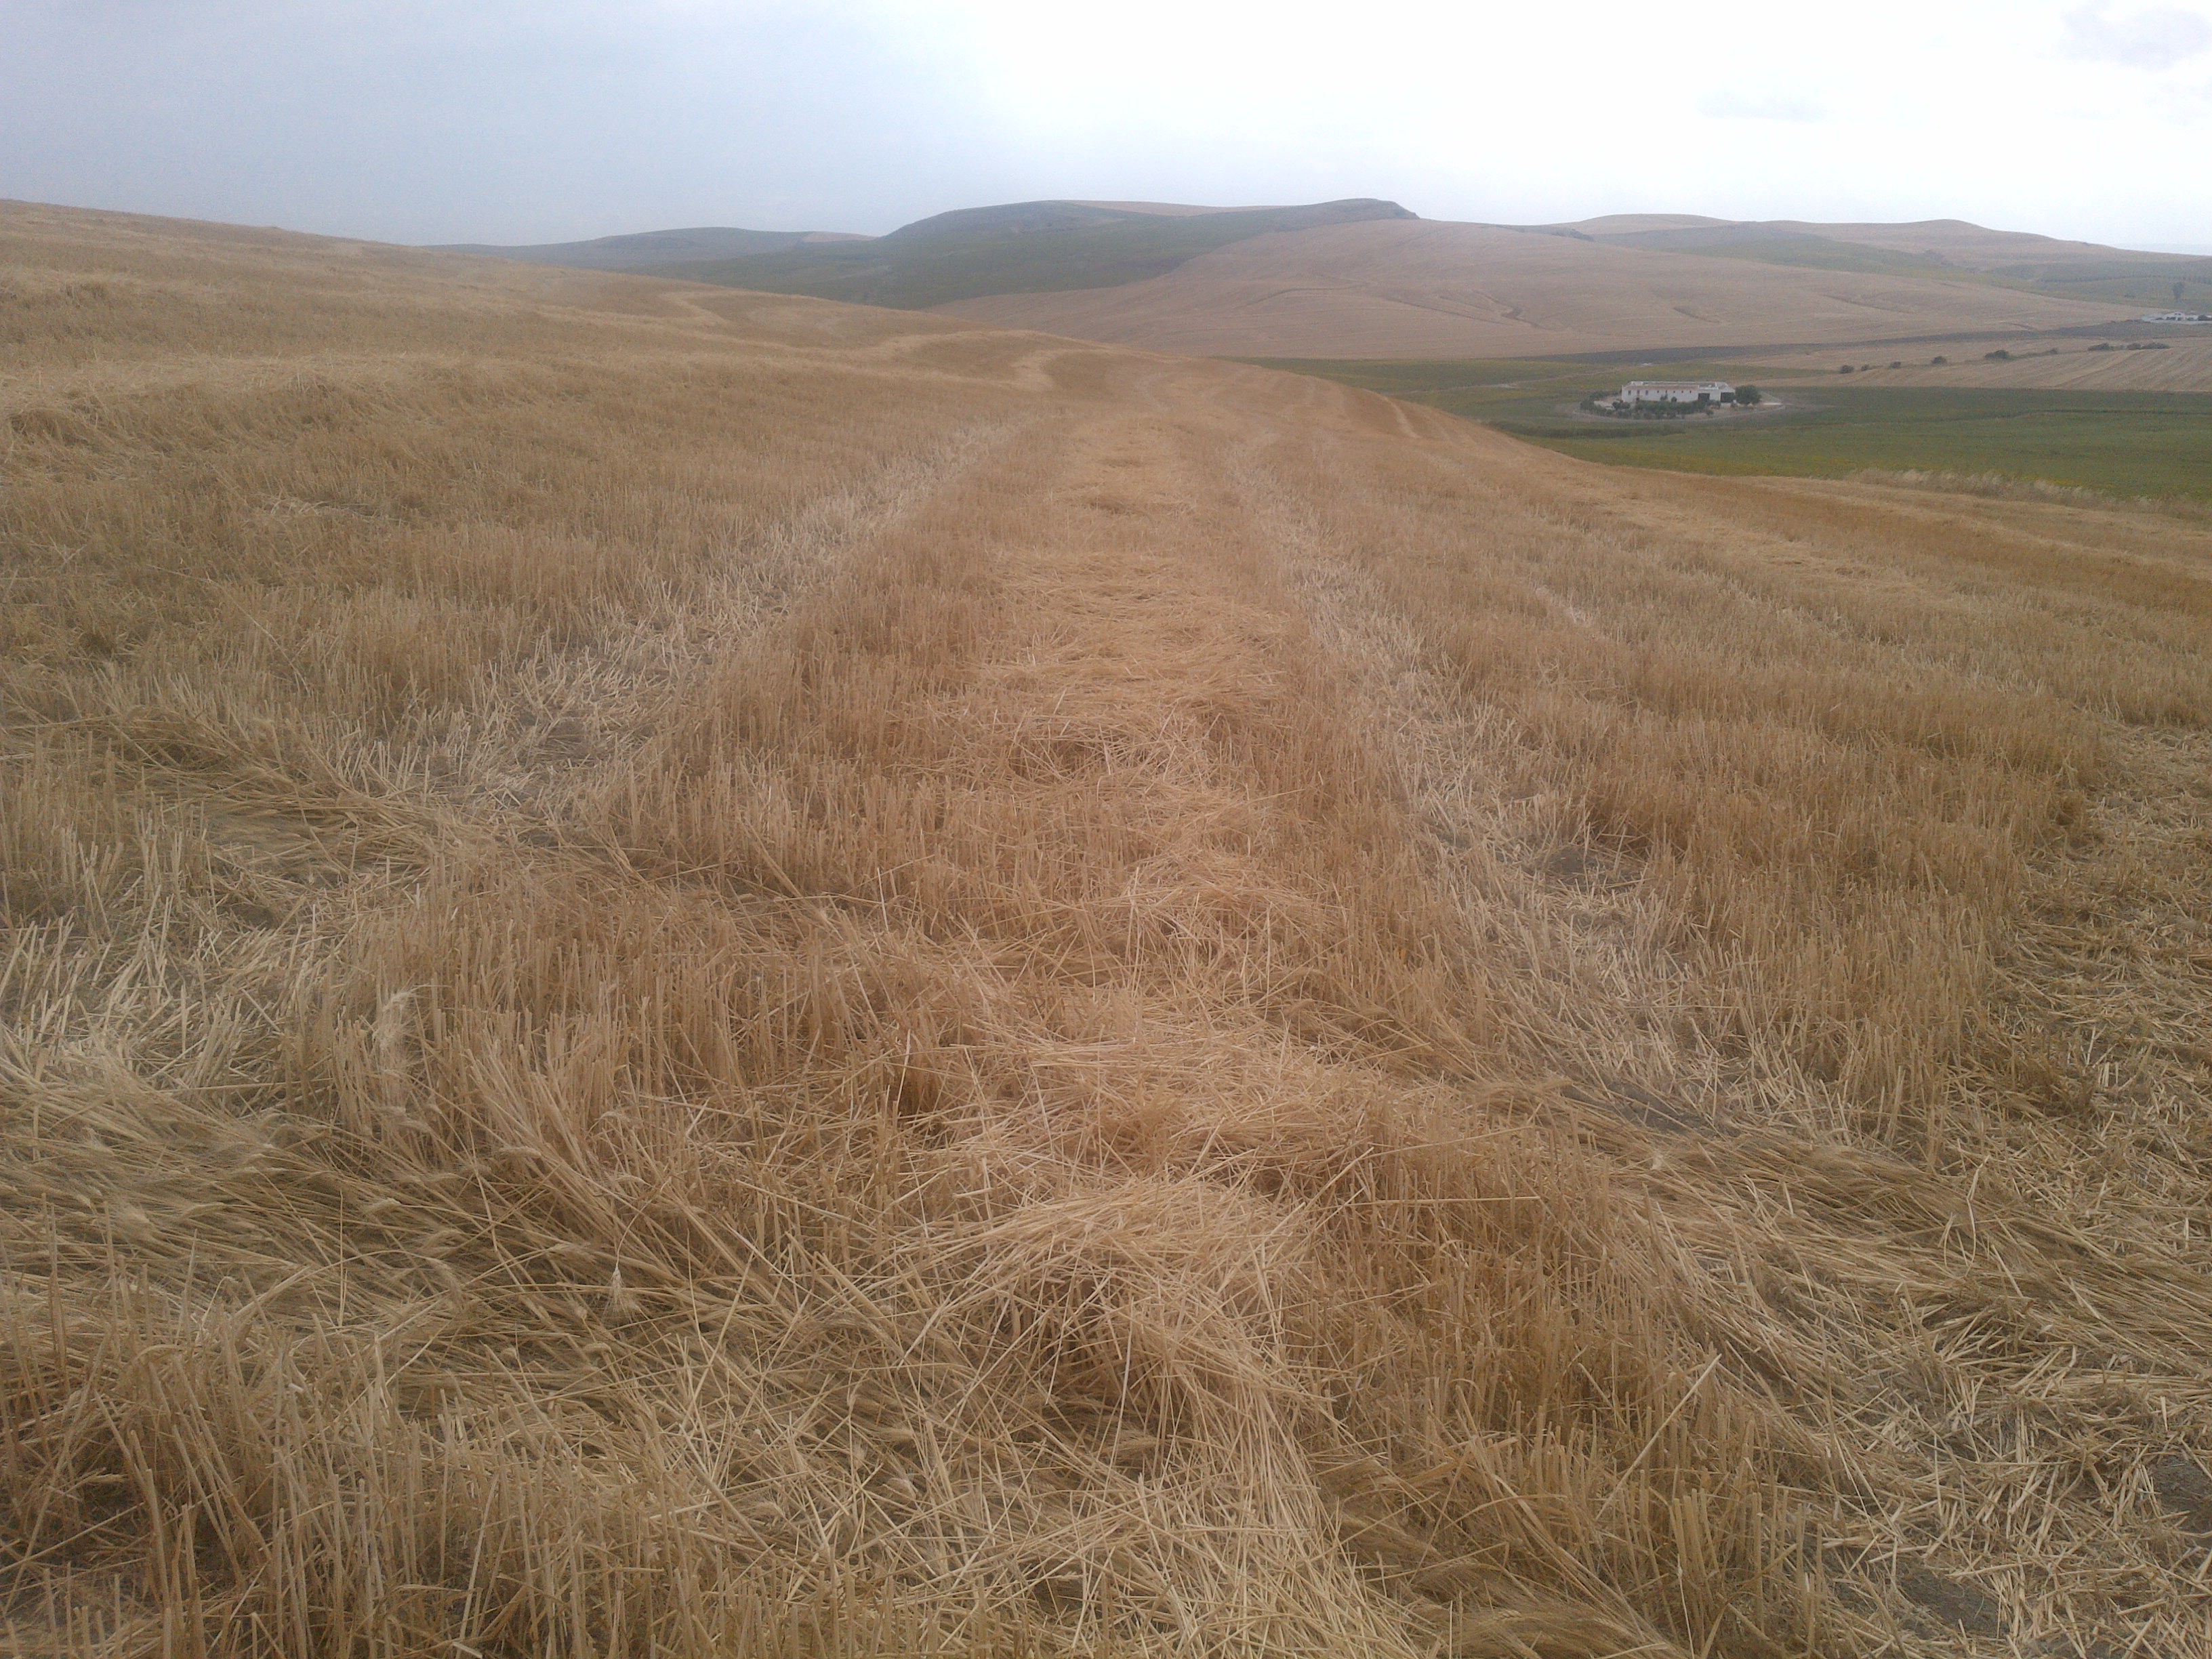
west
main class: Cropland
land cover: Durum wheat
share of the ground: < 10 %
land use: Agriculture (excluding fallow land and kitchen gardens)
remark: Harvested field
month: June
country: ES
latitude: 37.7797
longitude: -4.5542
